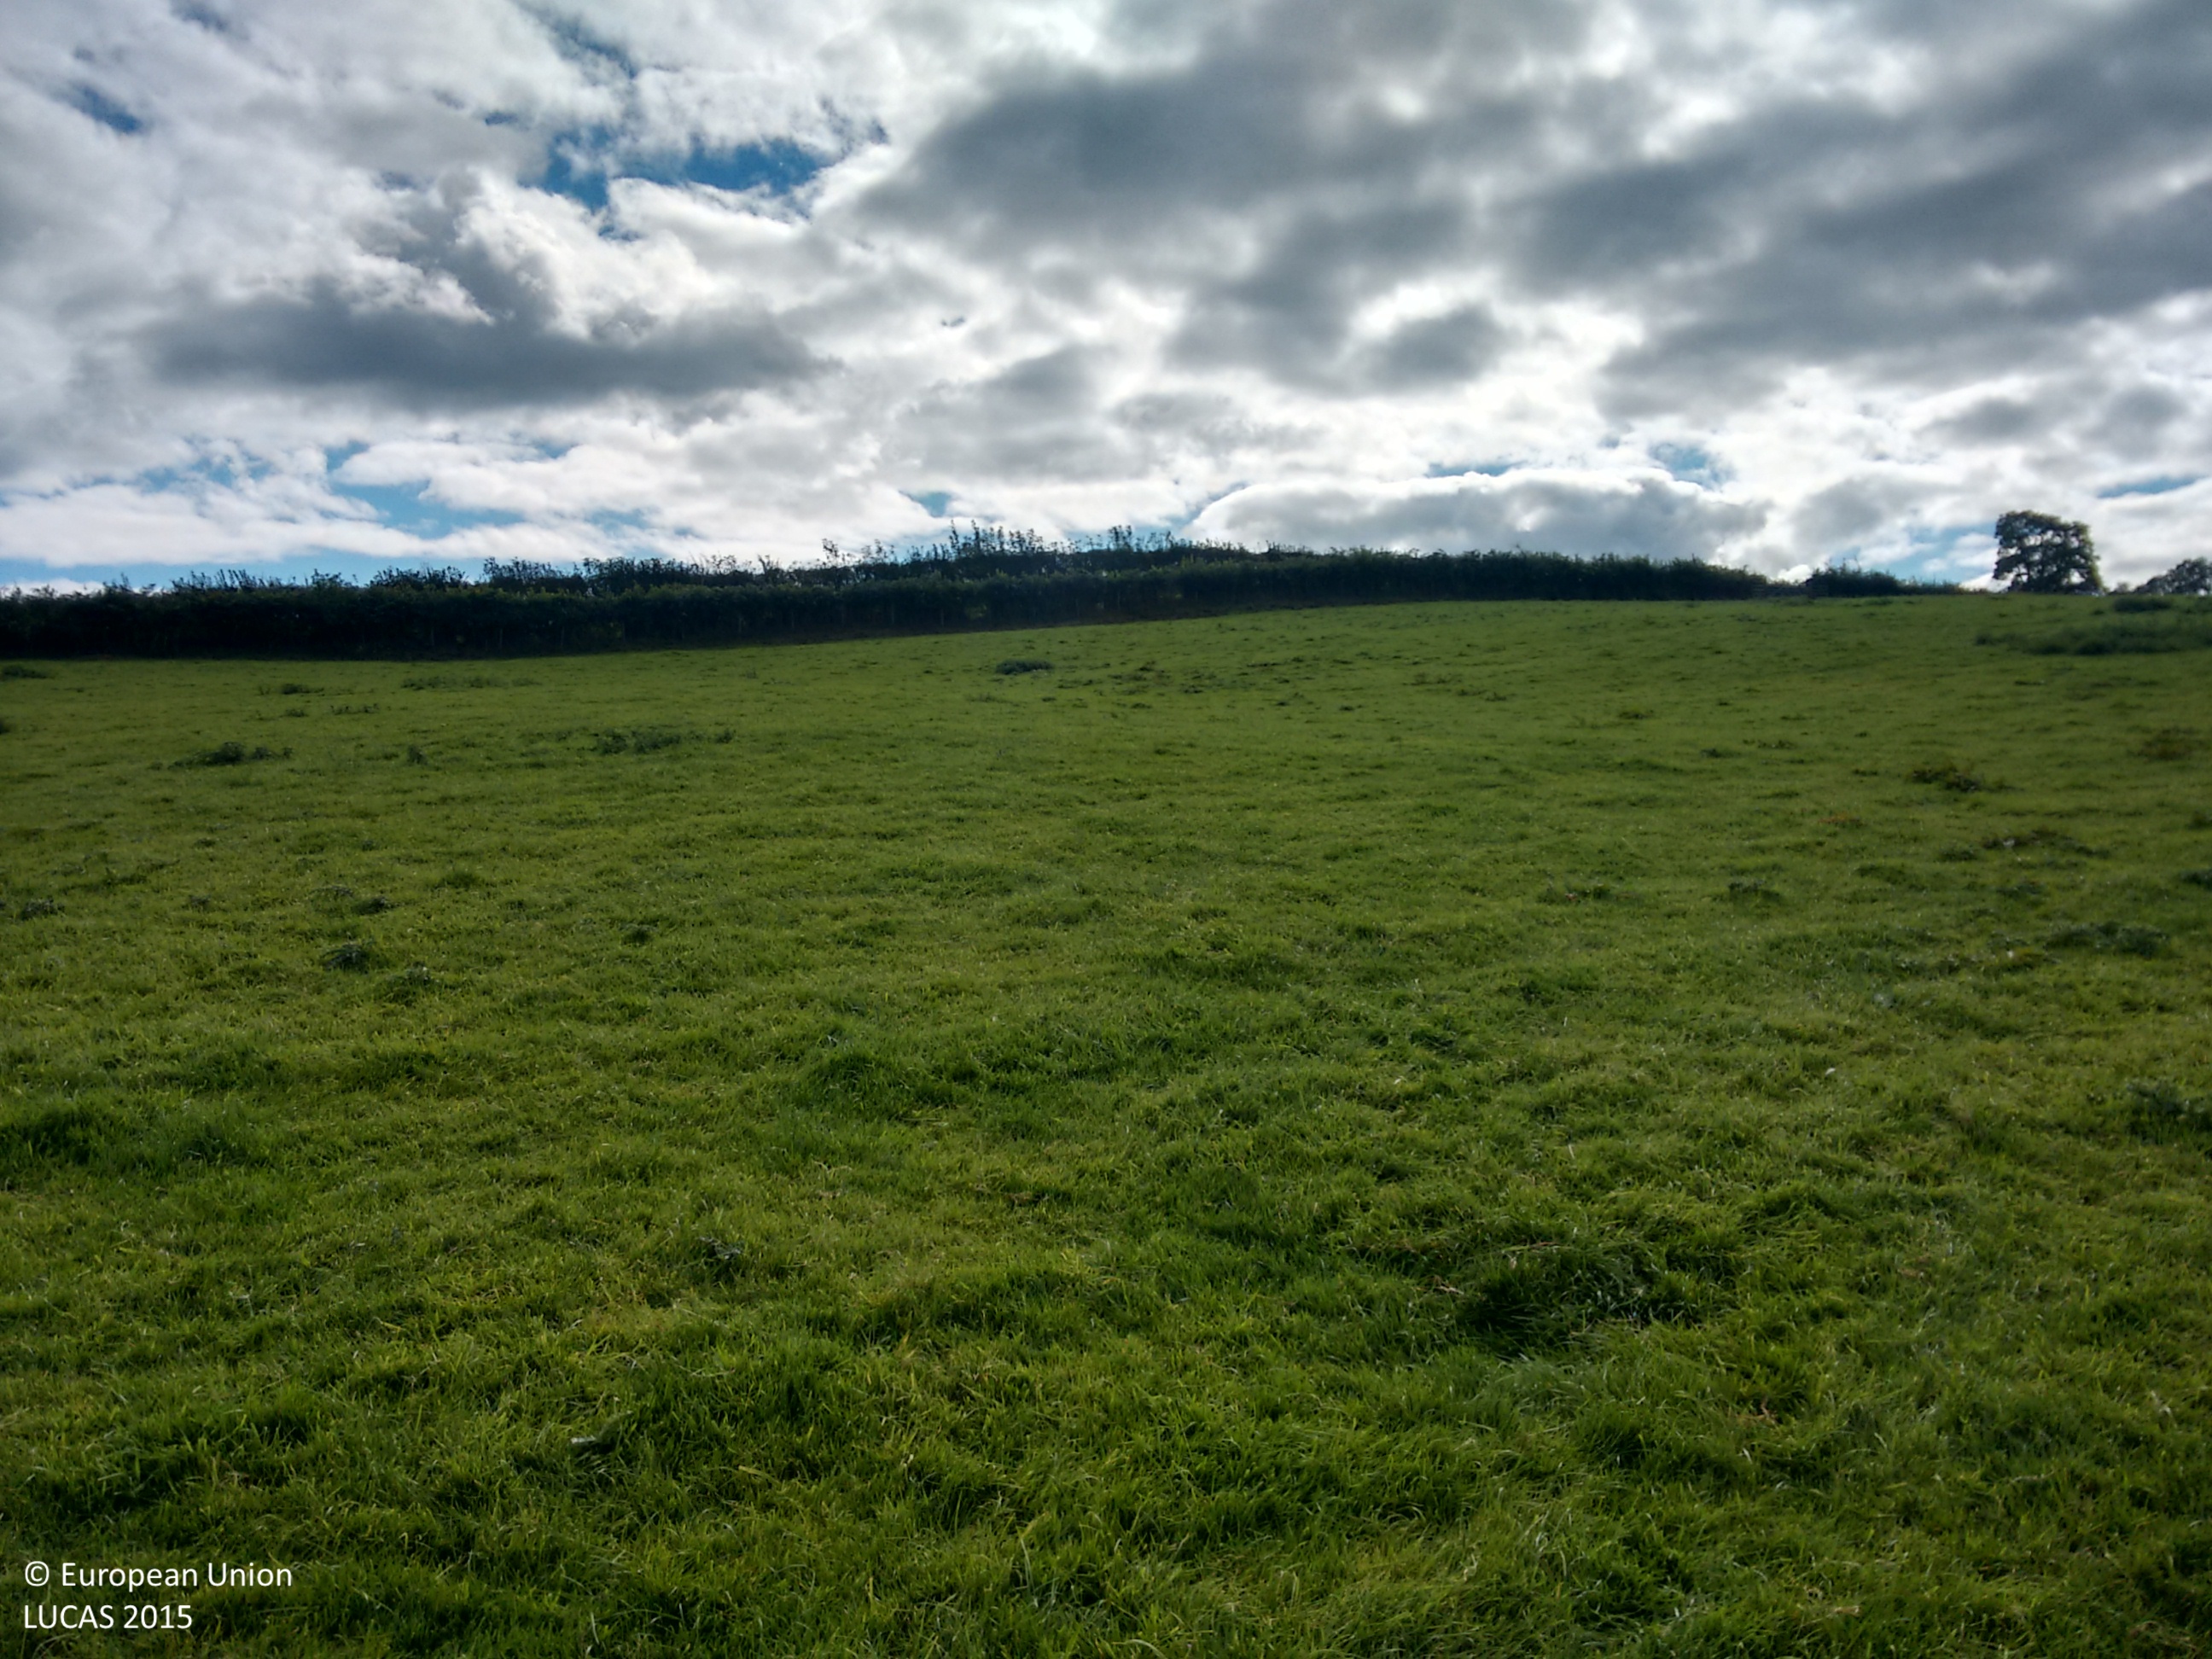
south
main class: Grassland
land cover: Grassland without tree/shrub cover
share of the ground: > 75 %
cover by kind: herbaceous plants 100 %
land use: Agriculture (excluding fallow land and kitchen gardens)
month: September
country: GB
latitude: 52.6944
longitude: -3.3537
